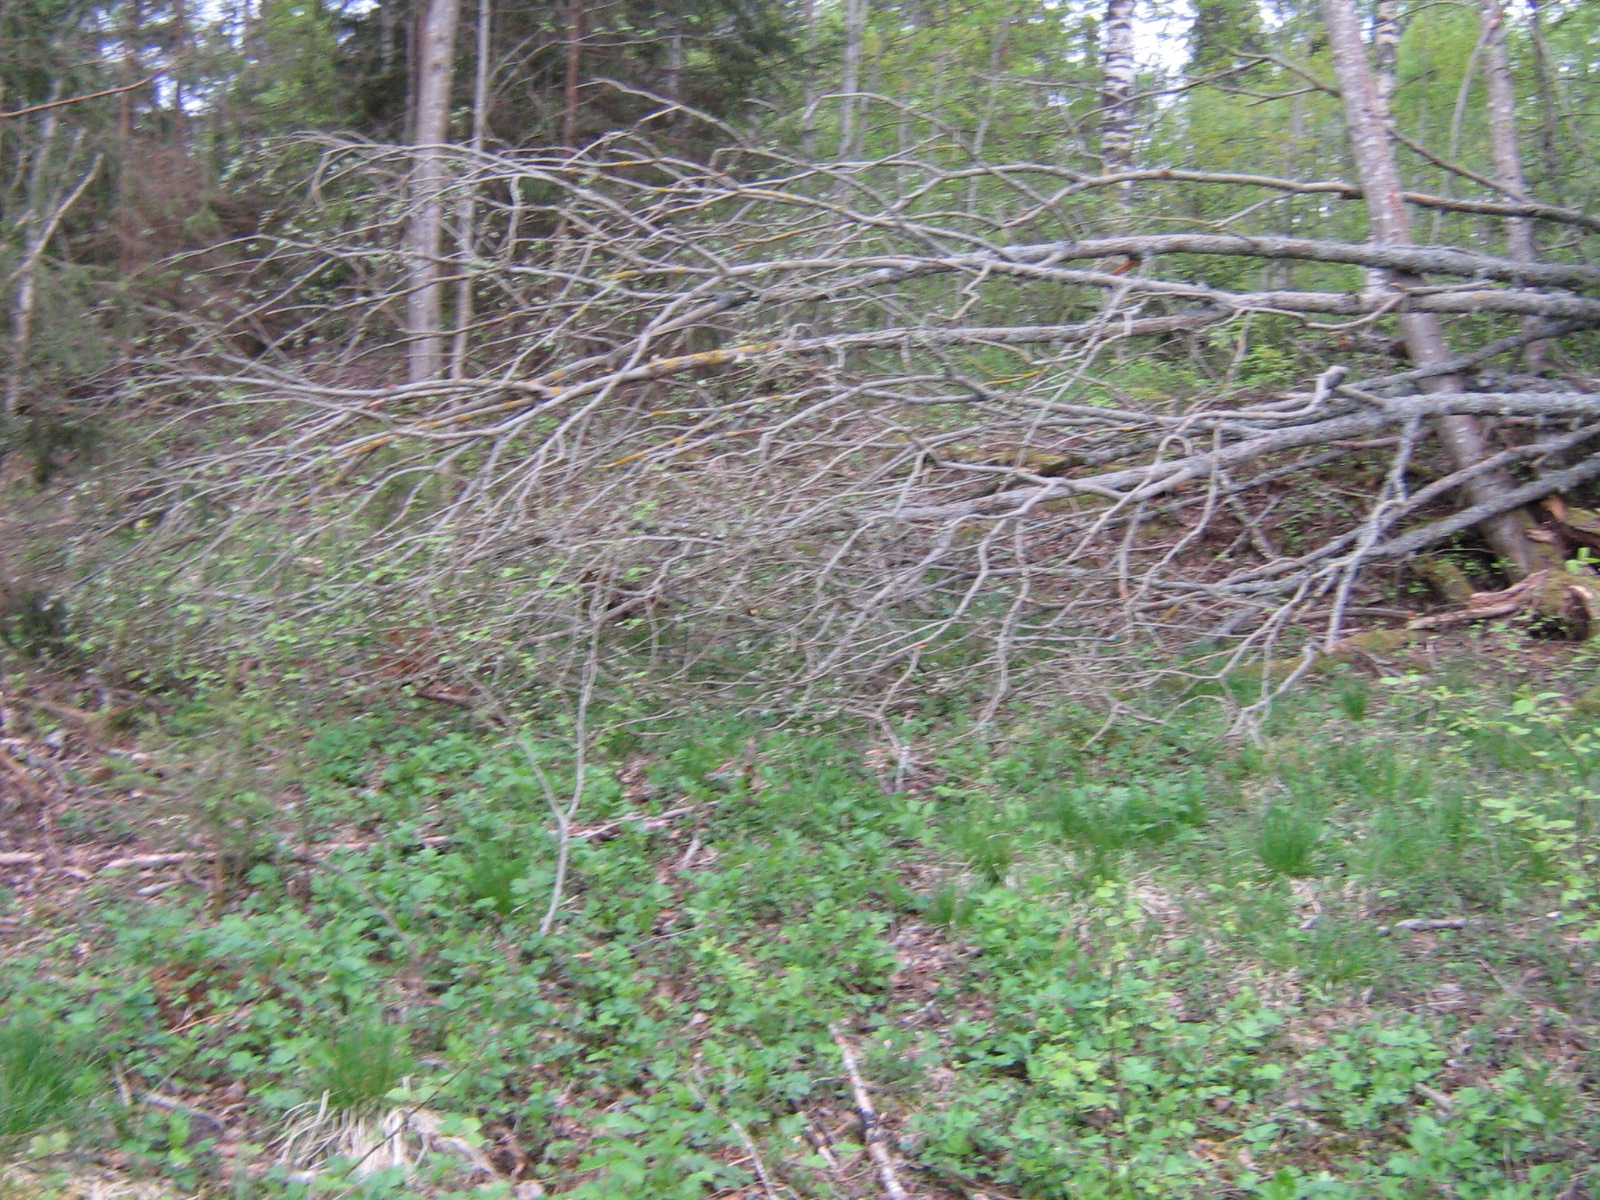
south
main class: Grassland
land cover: Spontaneously vegetated surfaces
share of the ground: > 75 %
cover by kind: herbaceous plants 75 %, lichens and mosses 25 %
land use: Forestry
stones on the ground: < 10 %
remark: Clear cut
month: May
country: LV
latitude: 57.1014
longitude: 25.7227
